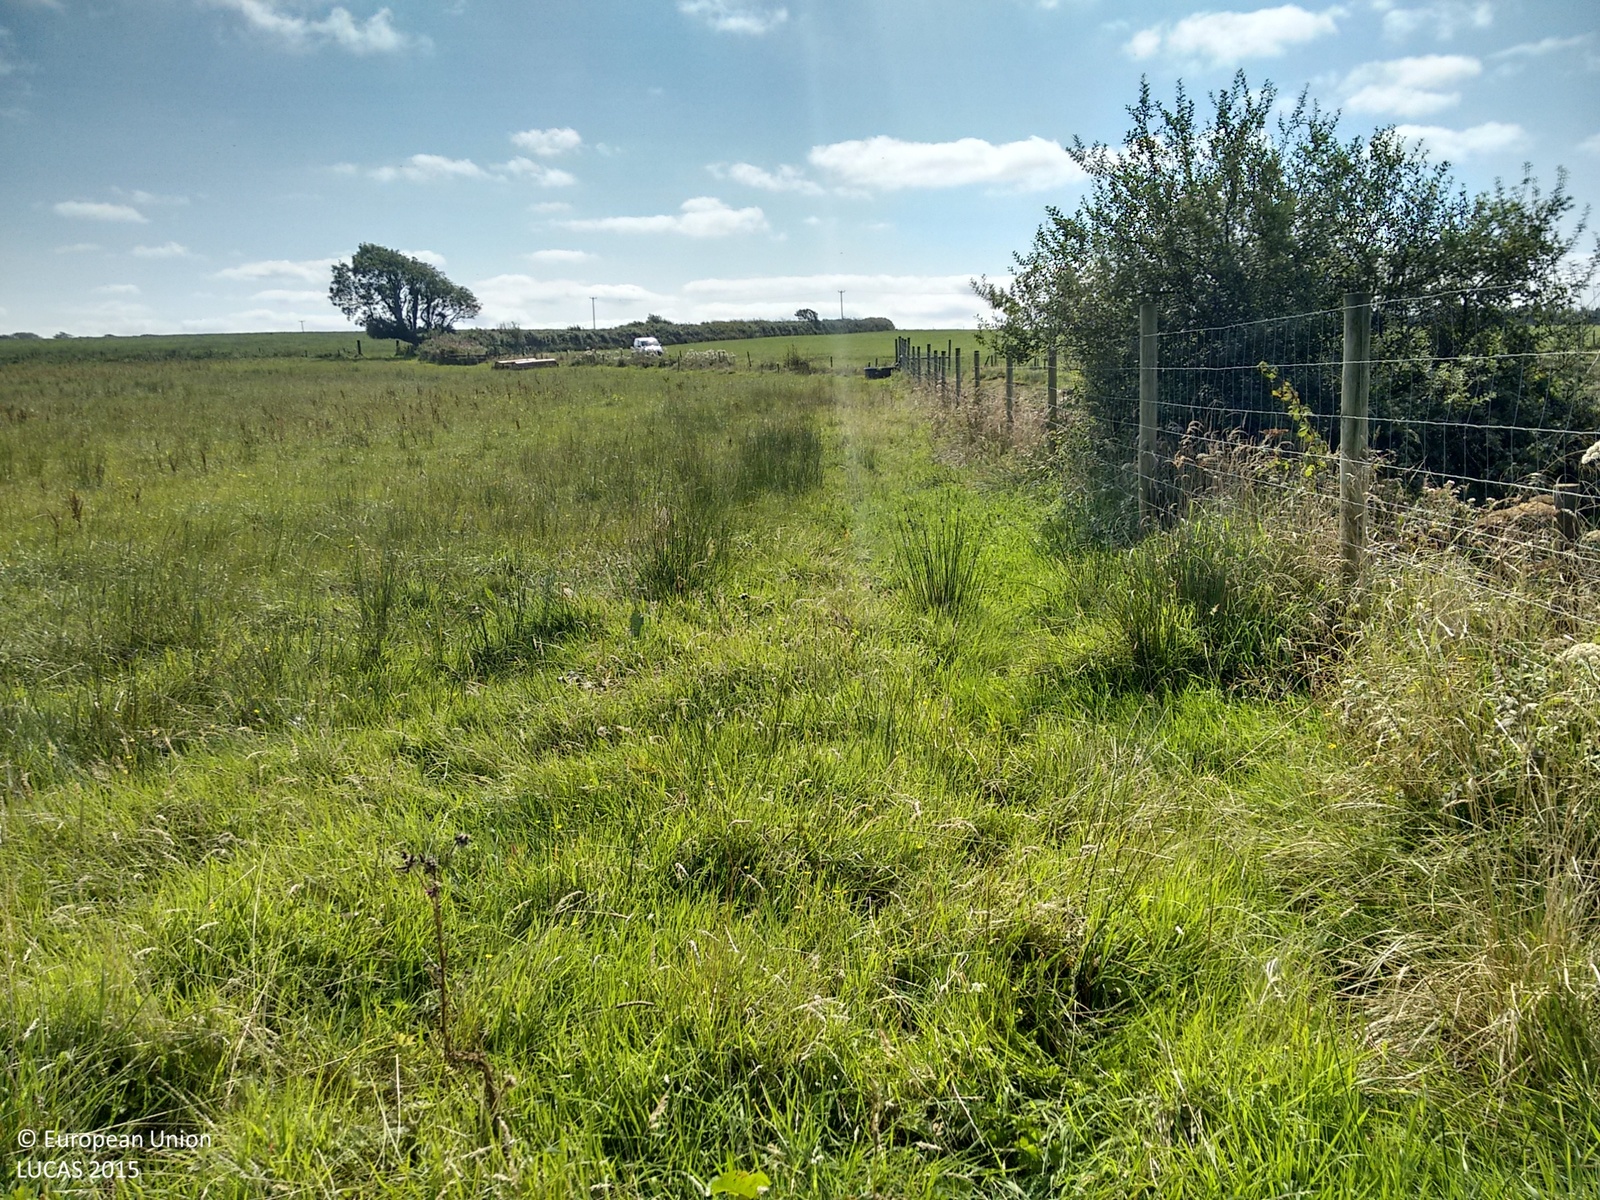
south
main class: Woodland
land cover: Broadleaved woodland
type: mesophytic deciduous forest
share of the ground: > 75 %
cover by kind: broadleaved forest trees 100 %
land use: Semi-natural and natural areas not in use
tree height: > 5 m
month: September
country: GB
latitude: 50.9582
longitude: -4.4402
